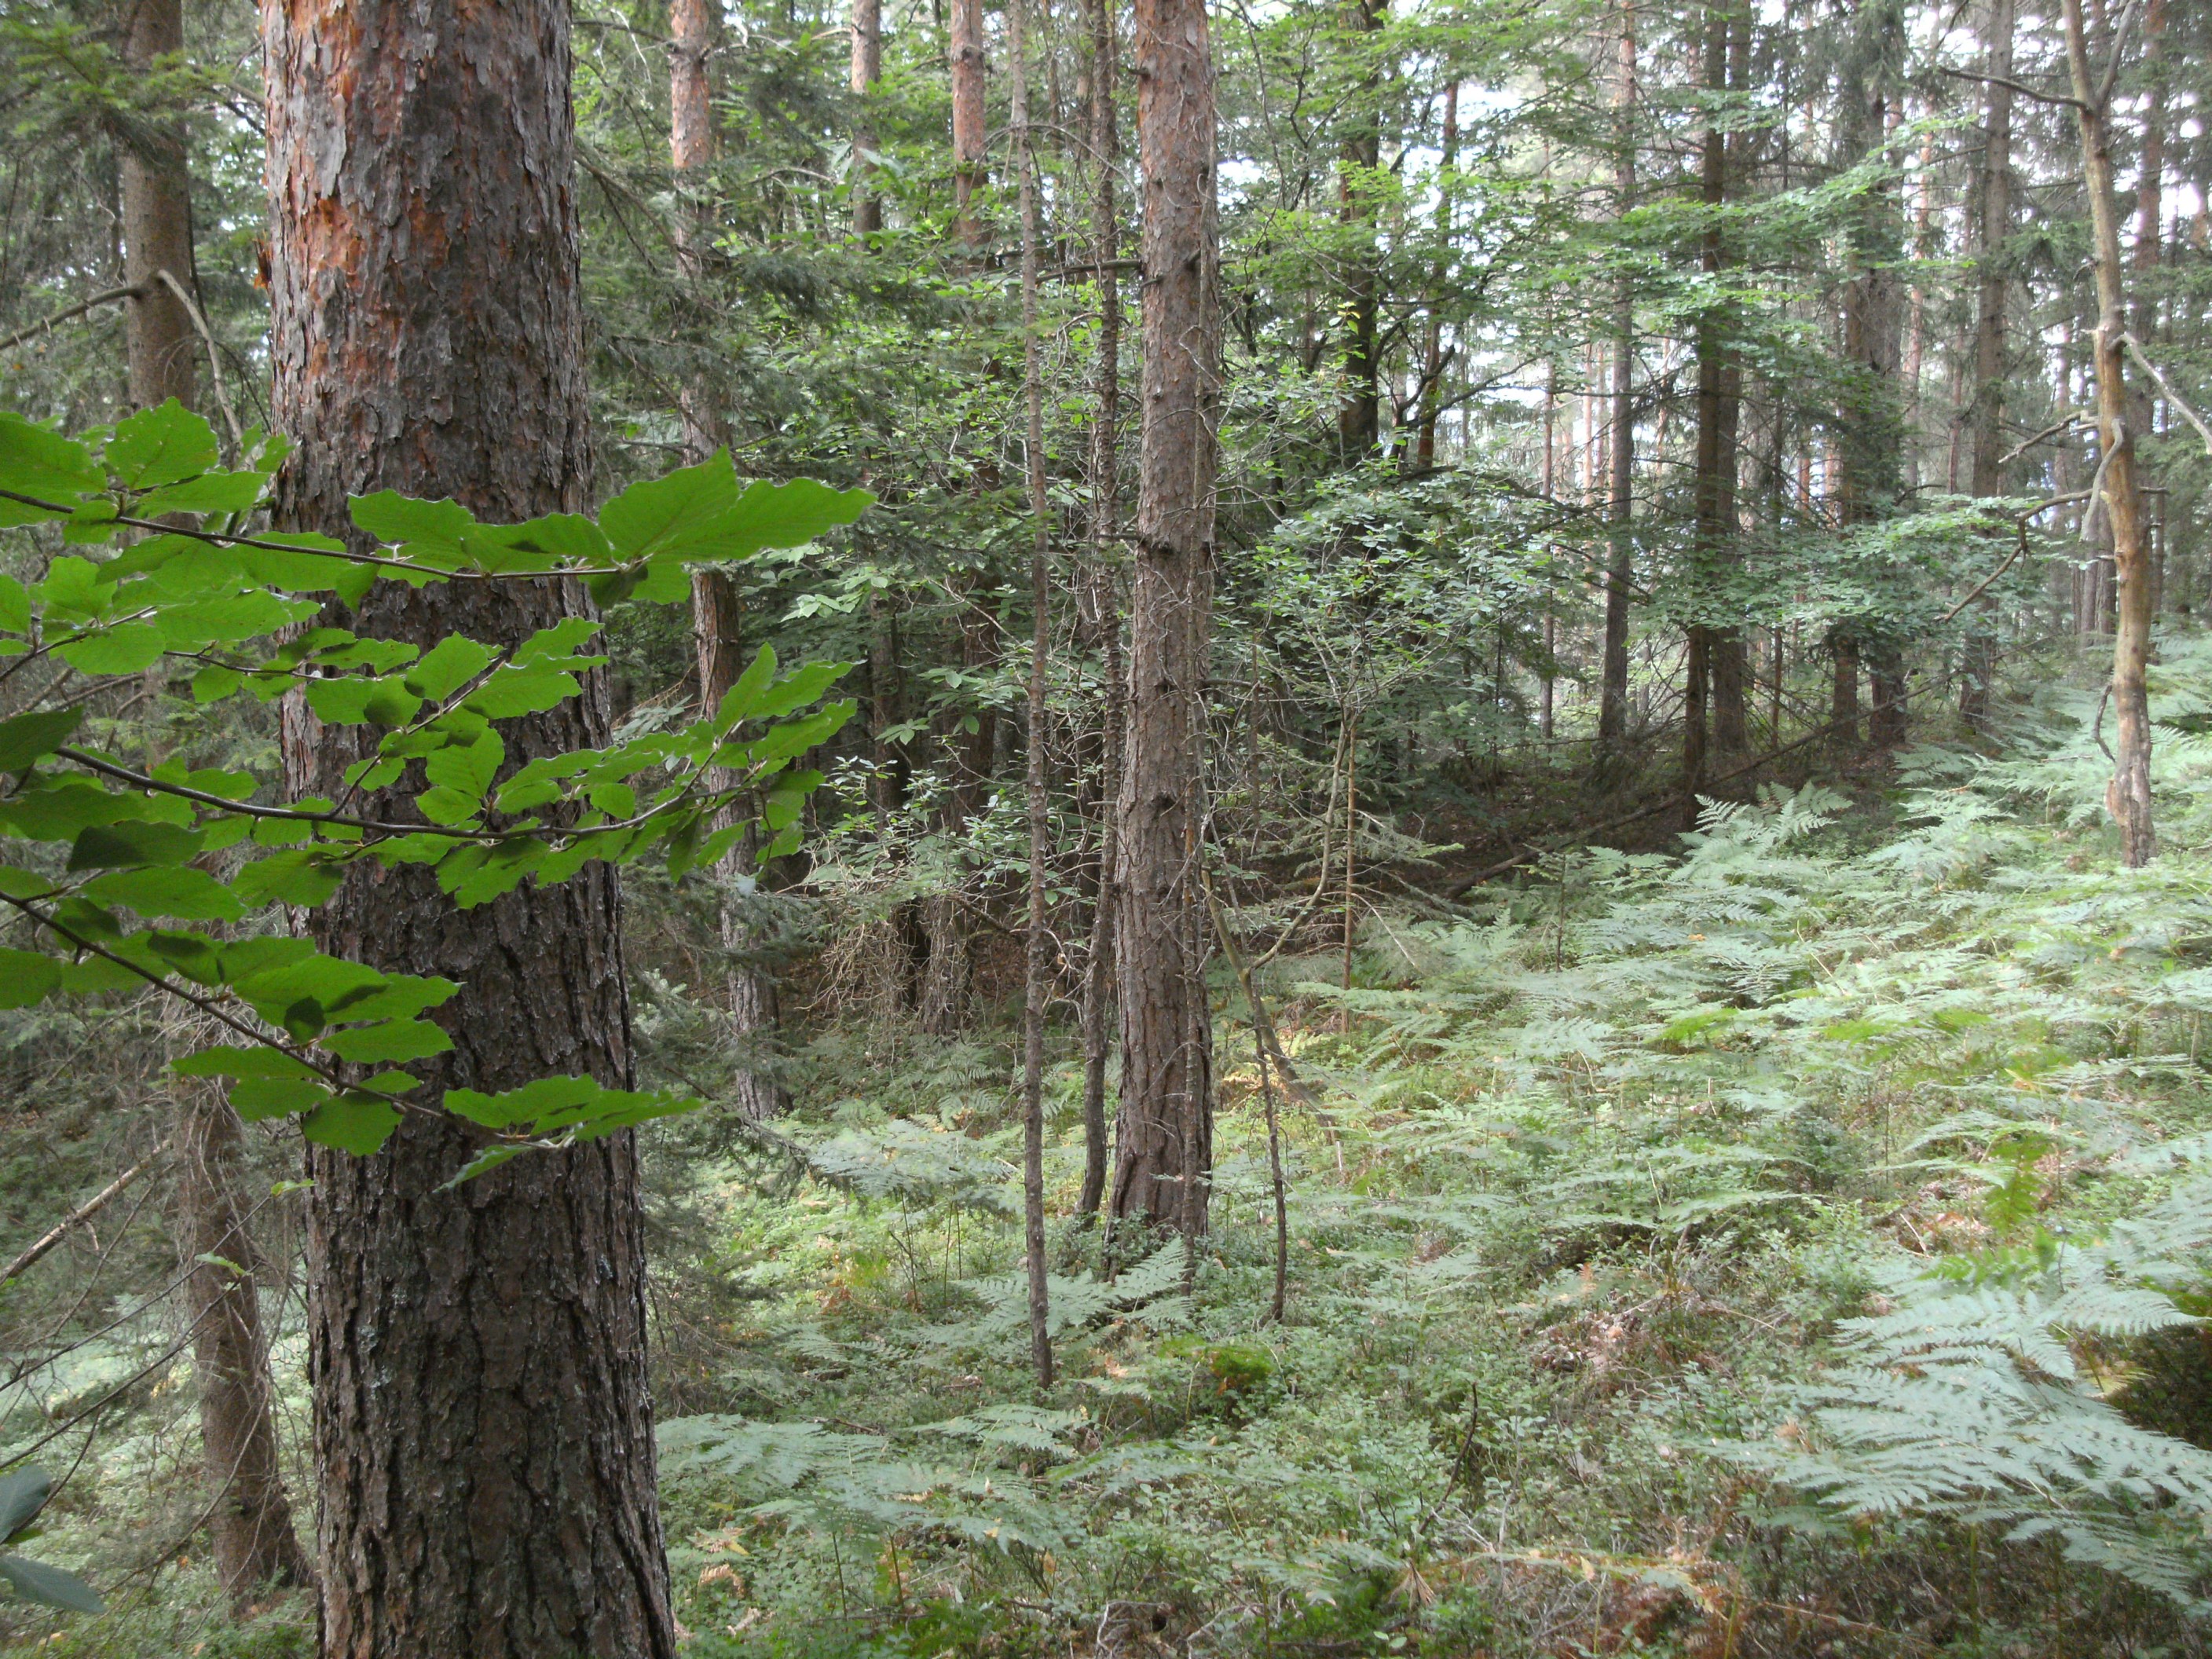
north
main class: Woodland
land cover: Pine dominated coniferous woodland
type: hemiboreal forest and nemoral coniferous forest and mixed broadleaved-coniferous forest
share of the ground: > 75 %
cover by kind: coniferous forest trees 70 %, broadleaved forest trees 10 %, shrubs 10 %, herbaceous plants 10 %
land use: Forestry
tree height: > 5 m
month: July
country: AT
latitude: 46.6216
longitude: 14.8168
